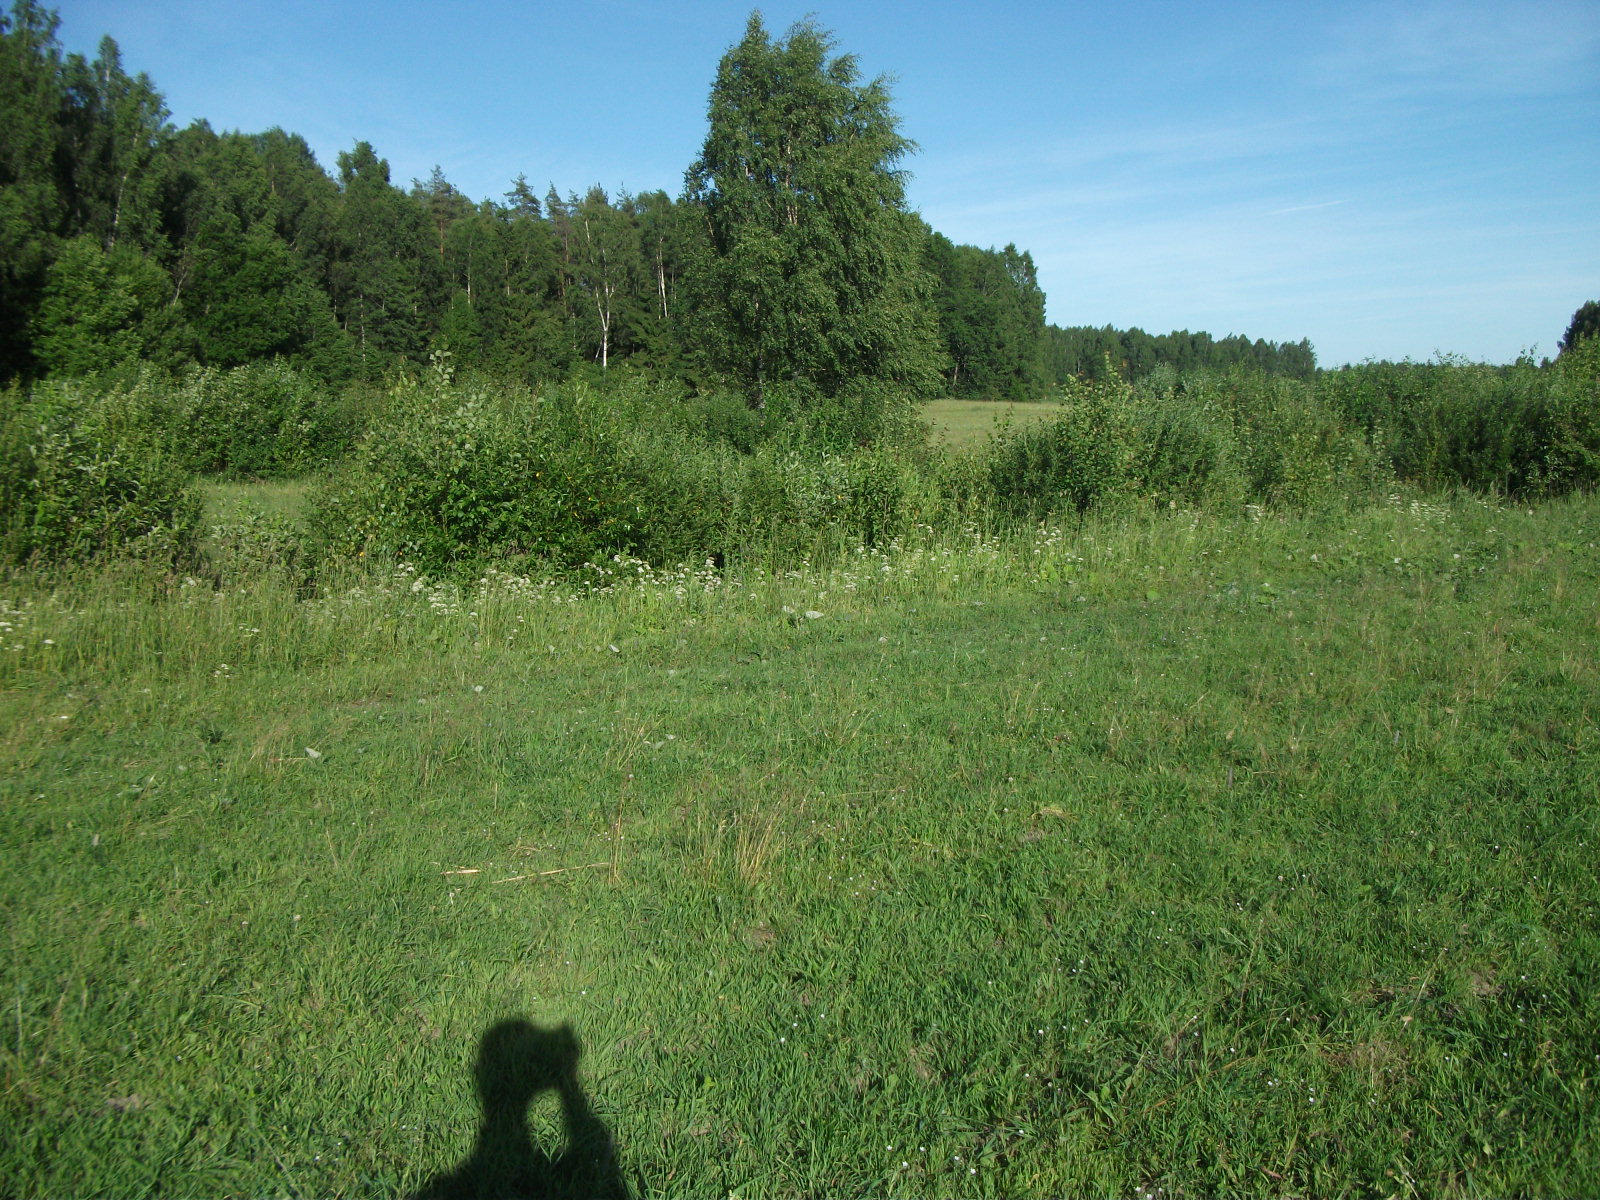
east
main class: Grassland
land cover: Grassland without tree/shrub cover
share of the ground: > 75 %
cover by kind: herbaceous plants 100 %
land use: Agriculture (excluding fallow land and kitchen gardens)
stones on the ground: < 10 %
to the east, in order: Grassland without tree/shrub cover; Abandoned hedges; Ditches and canals; Abandoned hedges; Grassland without tree/shrub cover; Abandoned hedges; Ditches and canals; Abandoned hedges; Grassland without tree/shrub cover; Broadleaved woodland; Ditches and canals; Spruce dominated mixed woodland; Spruce dominated coniferous woodland
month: July
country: LV
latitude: 56.8081
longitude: 26.3062
